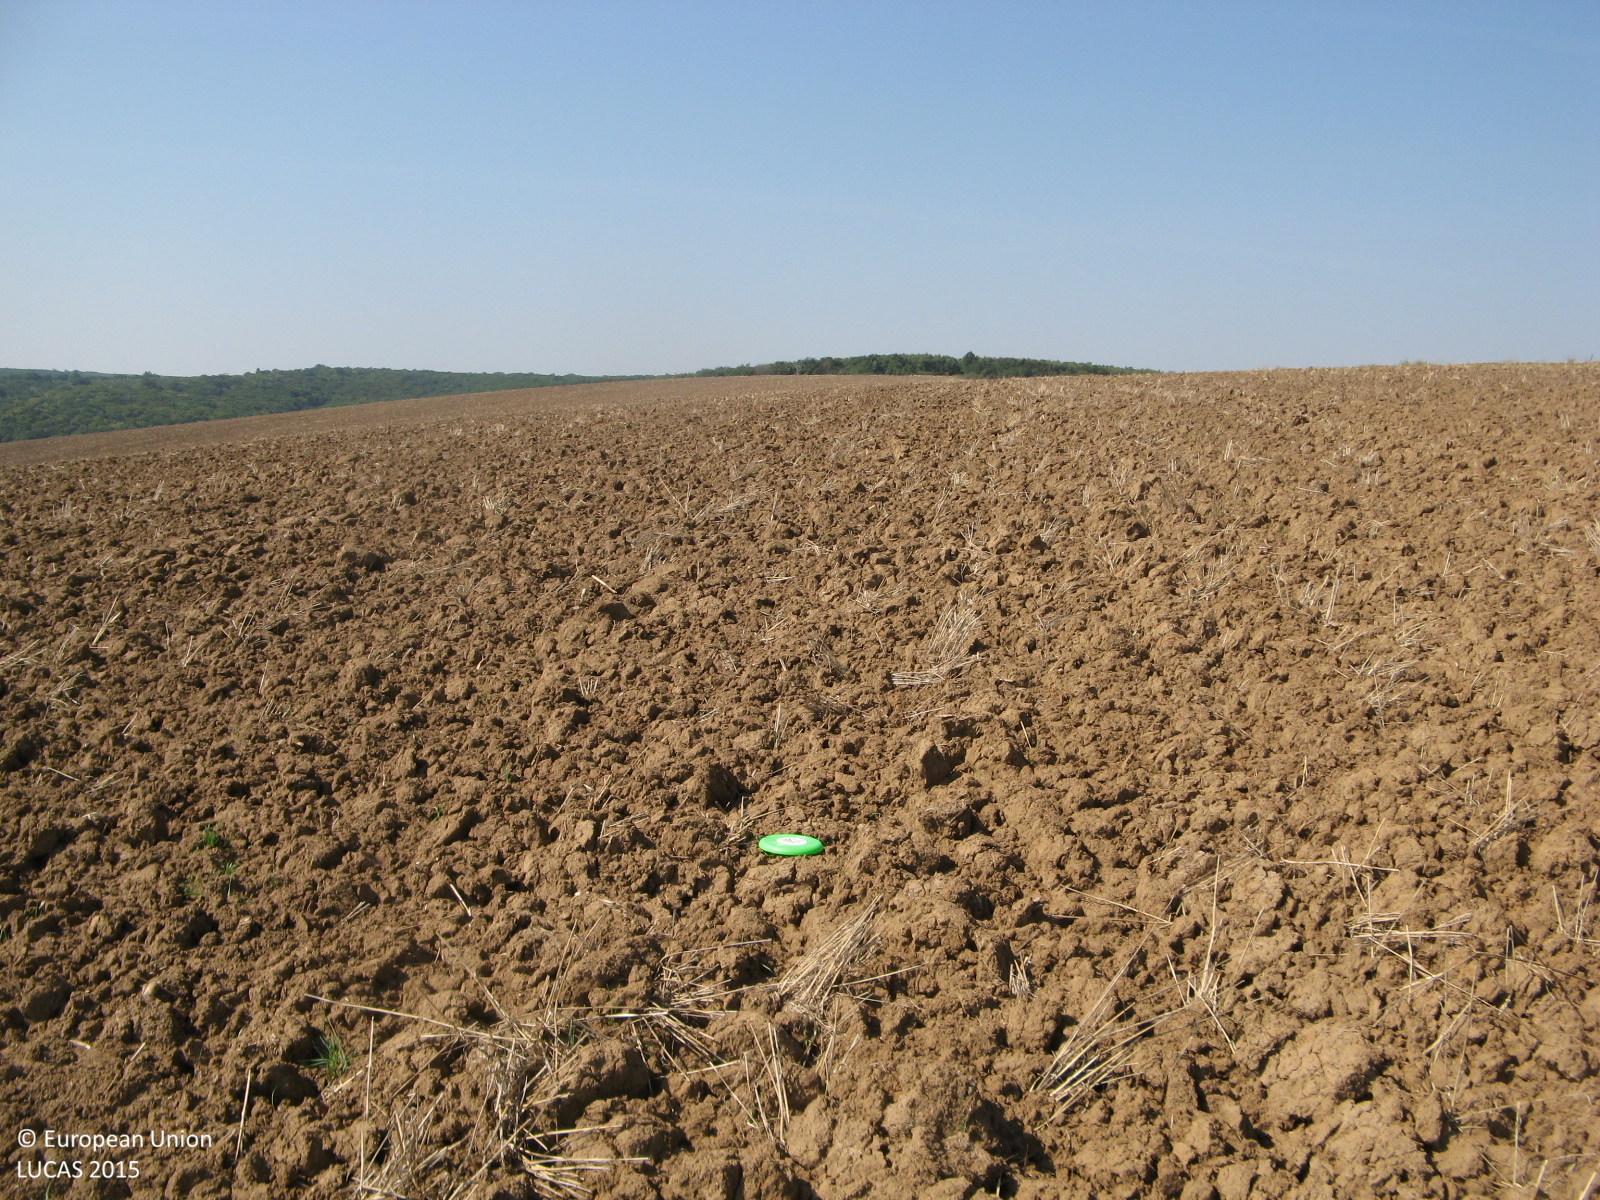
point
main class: Cropland
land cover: Common wheat
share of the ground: < 10 %
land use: Agriculture (excluding fallow land and kitchen gardens)
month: August
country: BG
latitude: 43.4680
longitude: 25.8744
